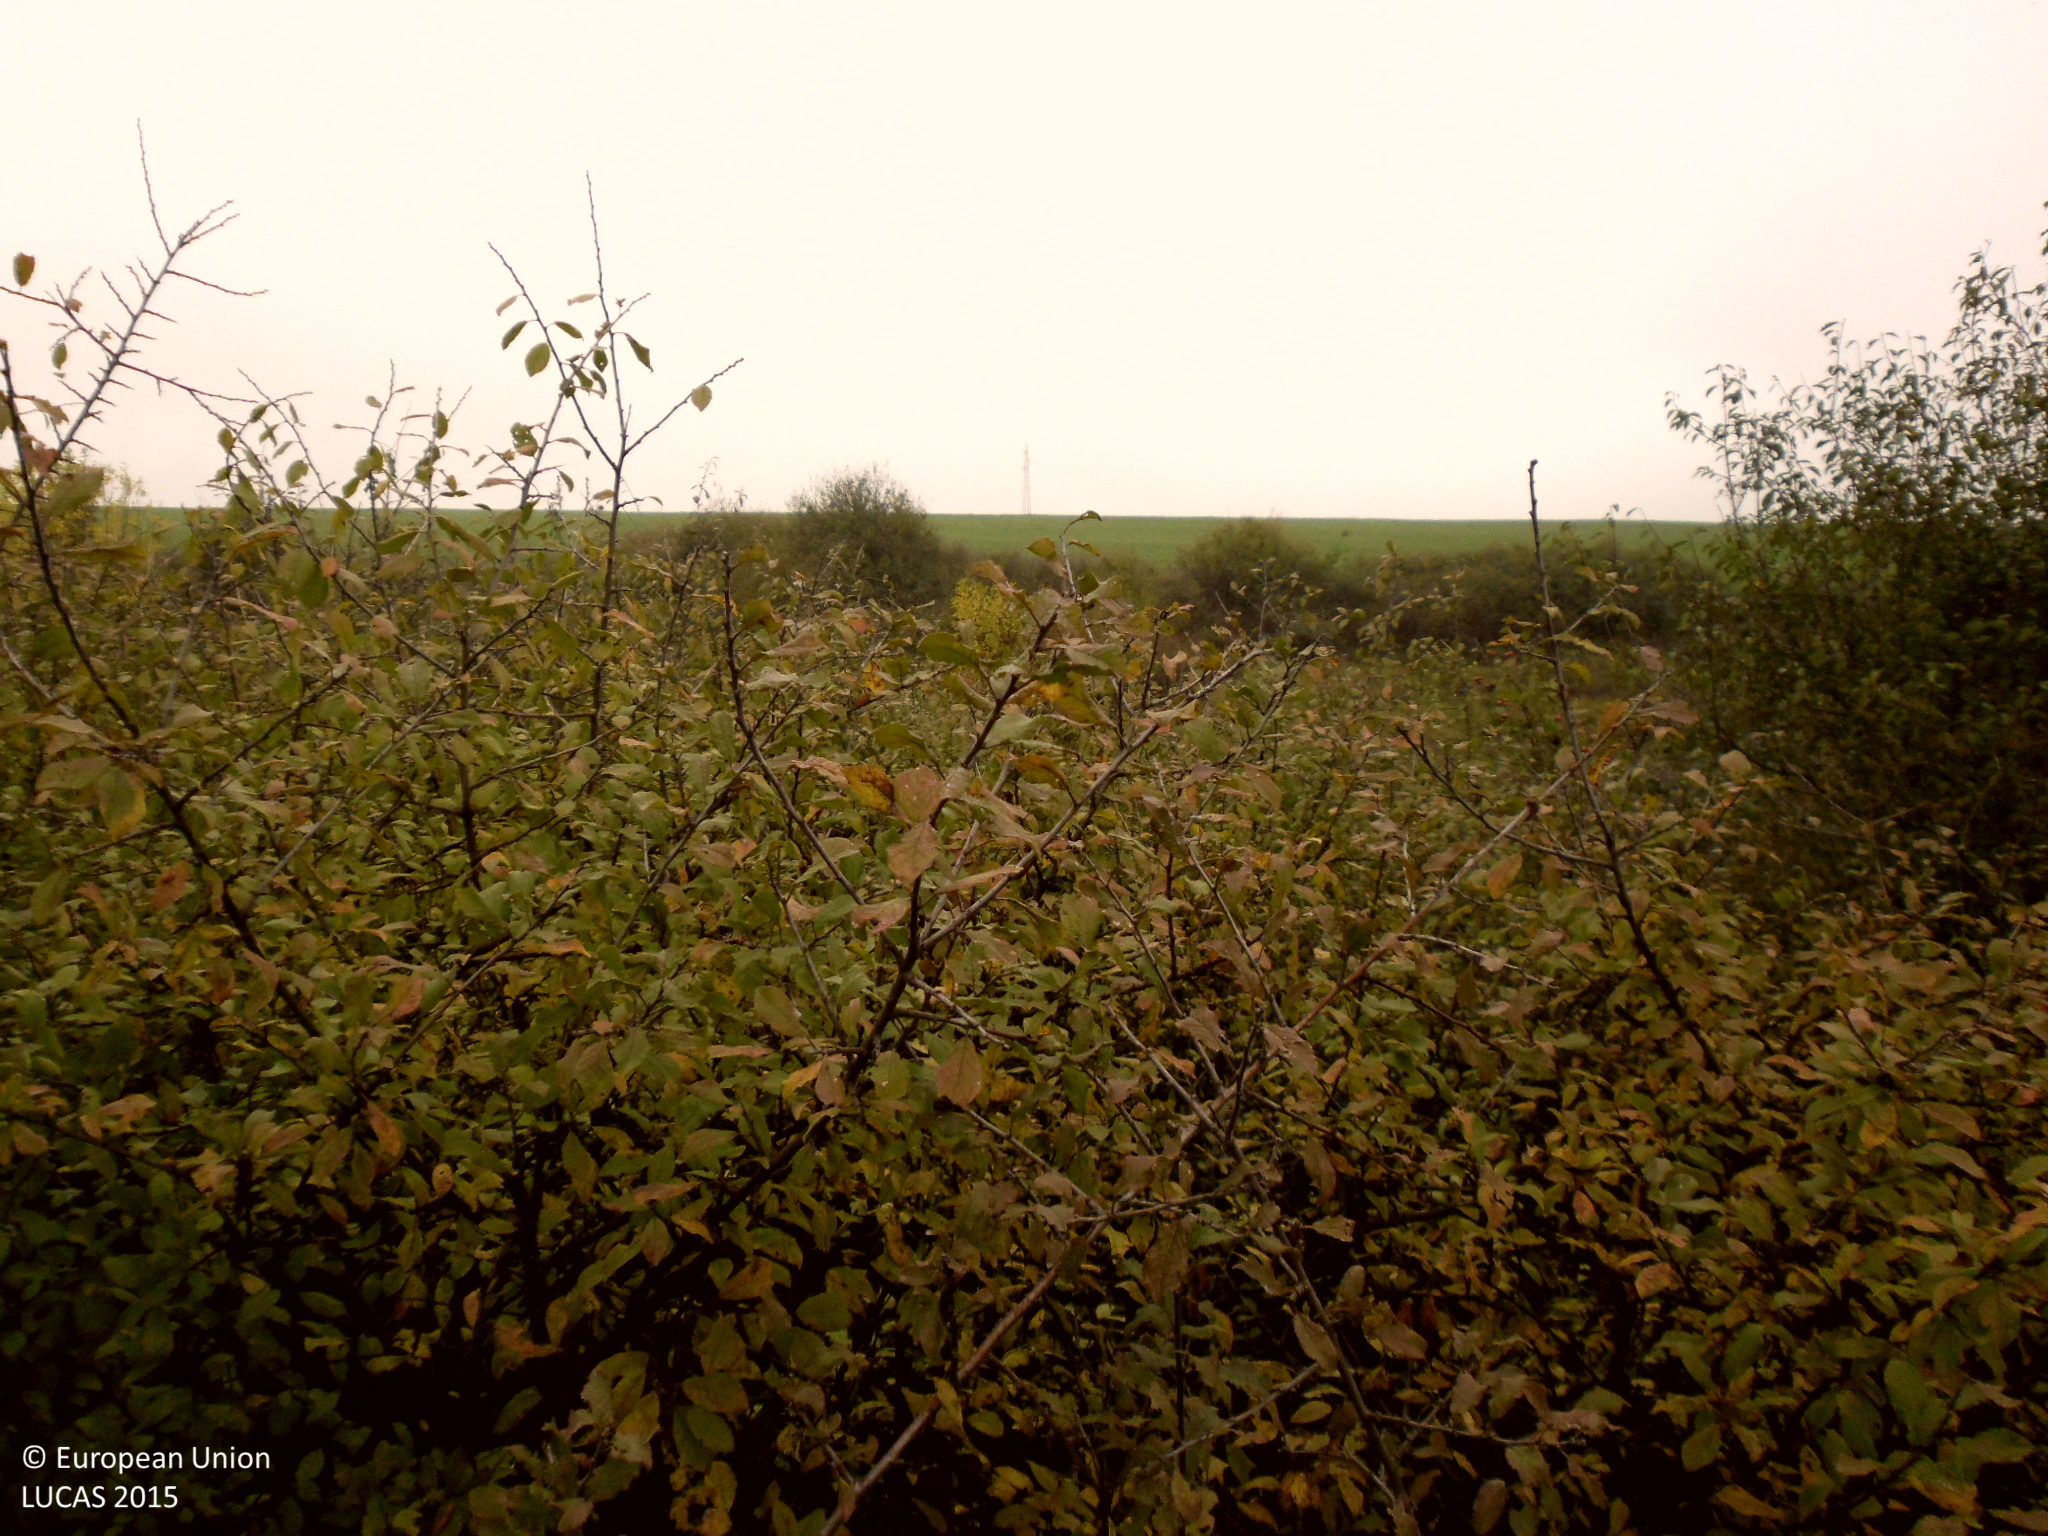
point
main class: Shrubland
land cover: Shrubland with sparse tree cover
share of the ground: > 75 %
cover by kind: shrubs 95 %, broadleaved forest trees 5 %
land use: Semi-natural and natural areas not in use
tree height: < 5 m
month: October
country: BG
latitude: 43.9223
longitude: 22.6272
